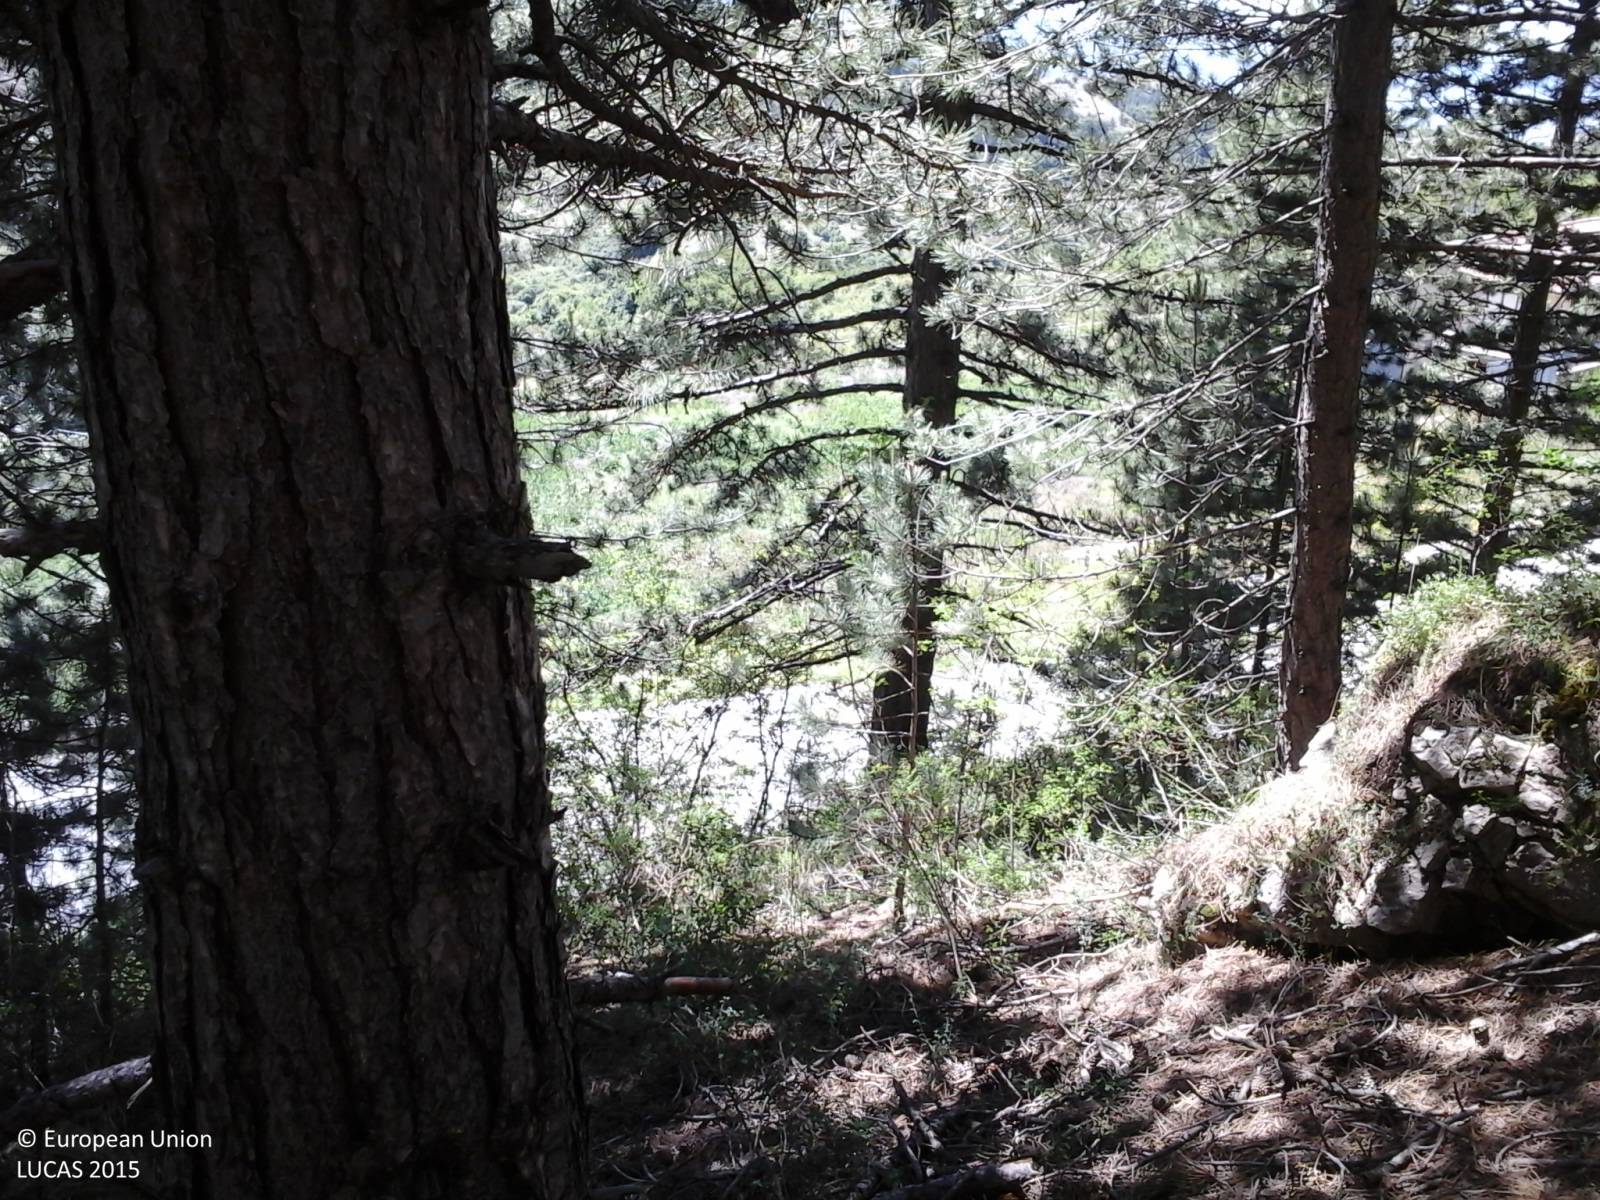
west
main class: Woodland
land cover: Pine dominated coniferous woodland
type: coniferous forest of the mediterranean region
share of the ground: > 75 %
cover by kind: coniferous forest trees 90 %, broadleaved forest trees 5 %, shrubs 5 %
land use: Forestry
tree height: > 5 m
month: June
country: IT
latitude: 41.8980
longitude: 13.7356
